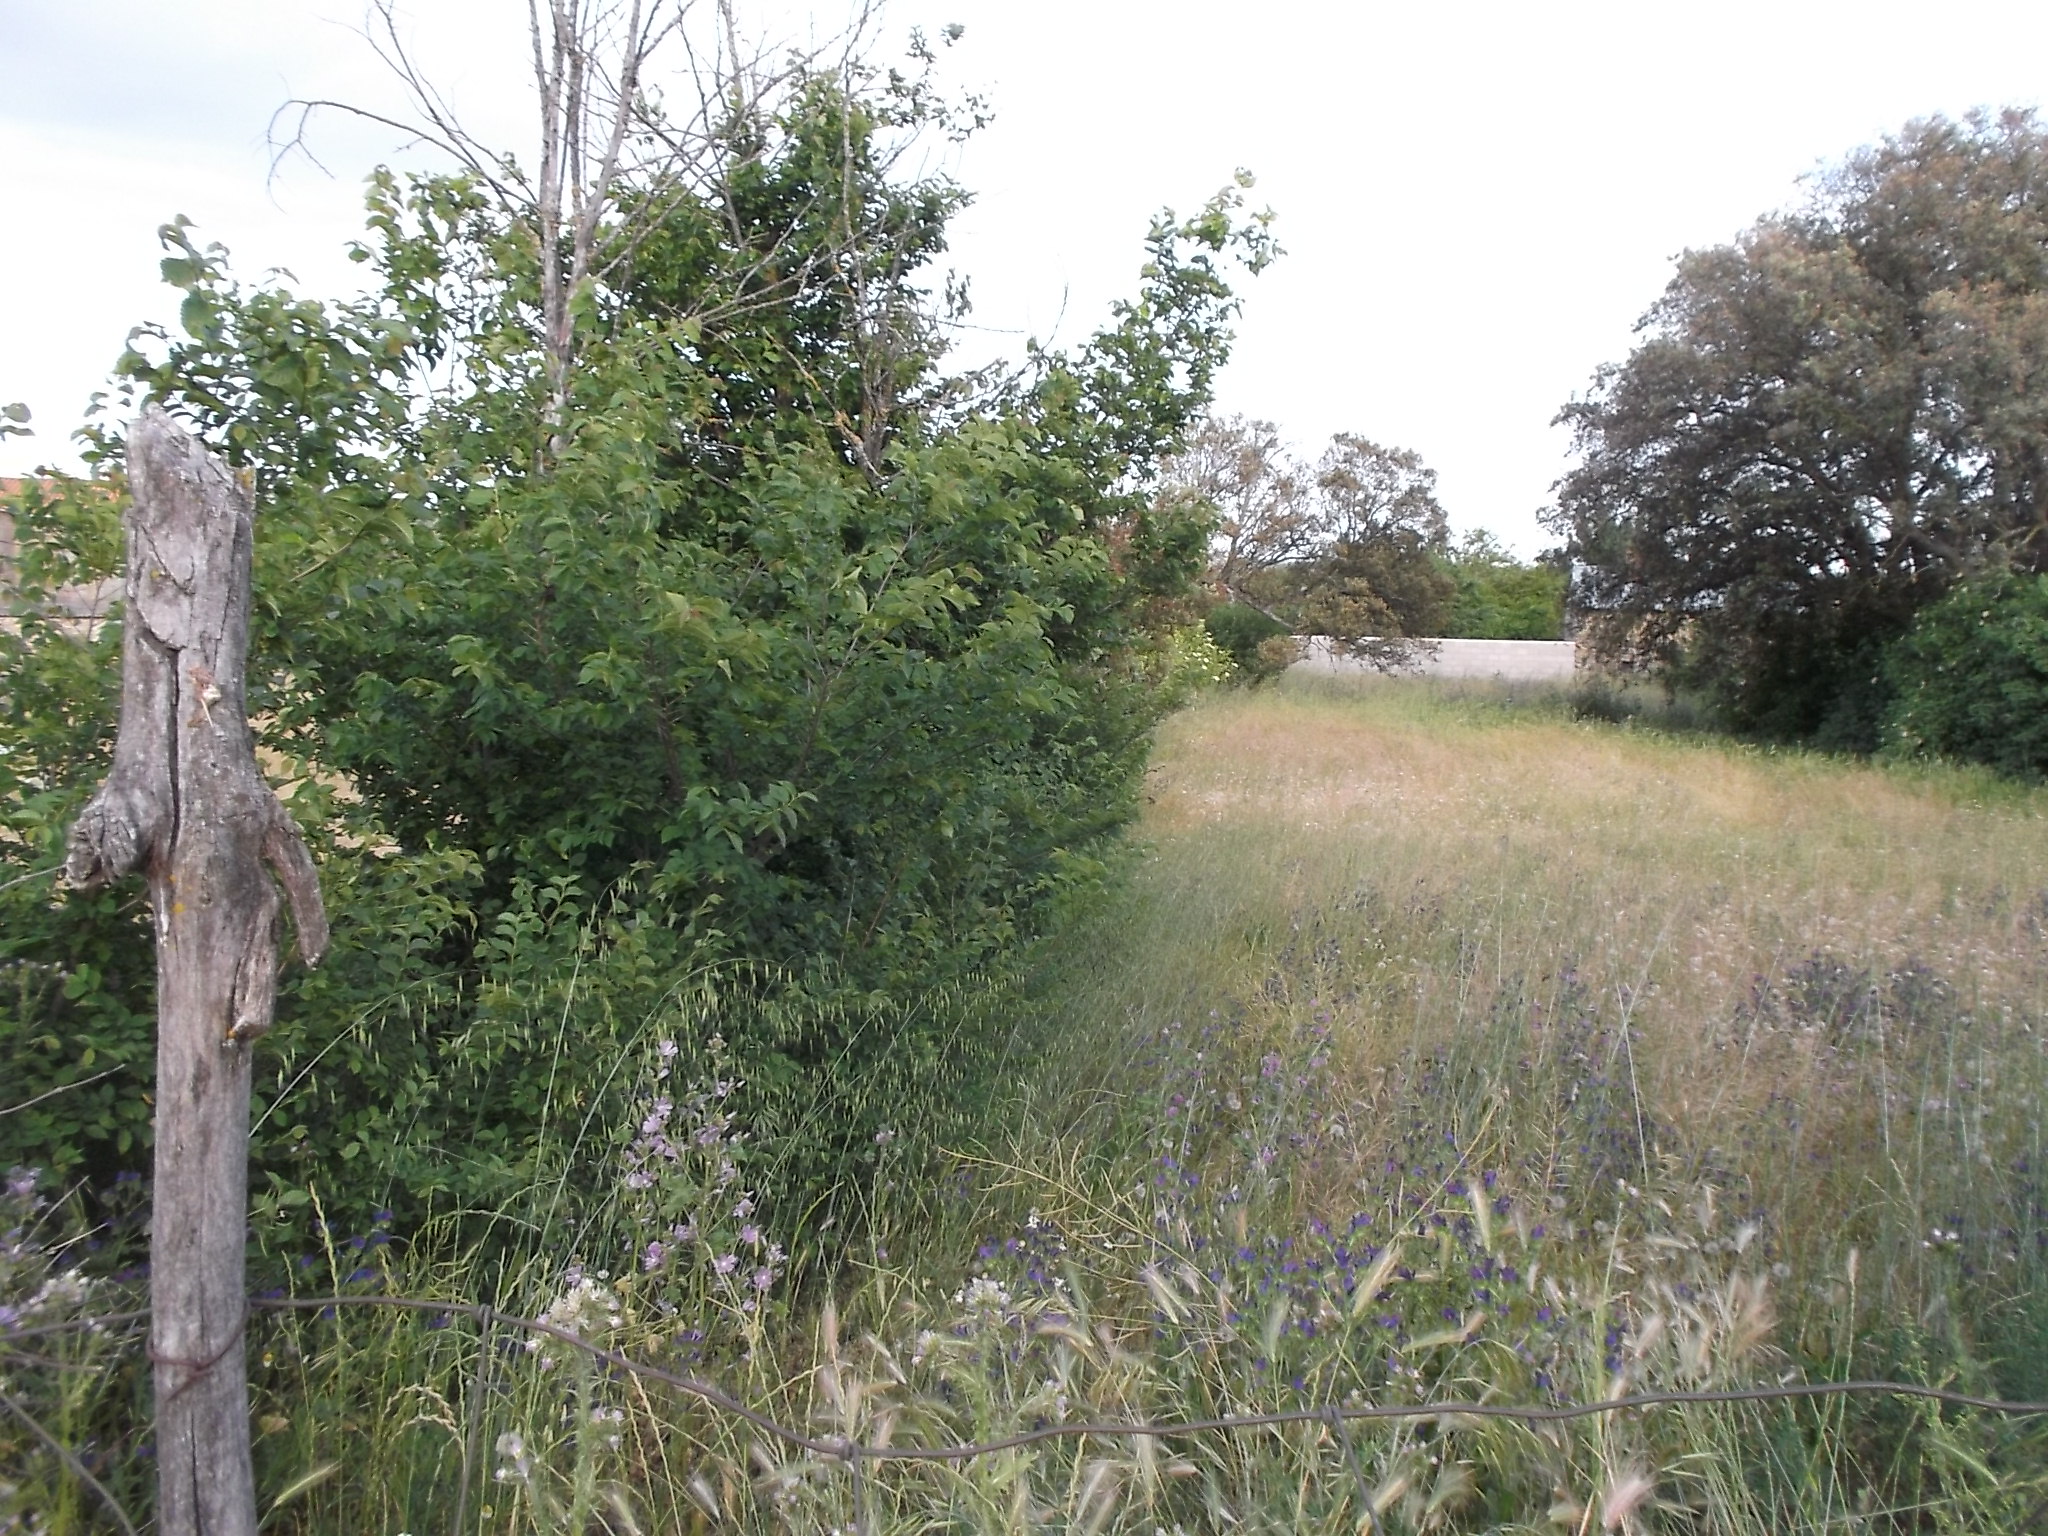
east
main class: Grassland
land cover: Grassland without tree/shrub cover
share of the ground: > 75 %
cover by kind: herbaceous plants 100 %
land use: Agriculture (excluding fallow land and kitchen gardens)
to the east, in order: Grassland without tree/shrub cover; Artificial constructions in urban areas; Grassland without tree/shrub cover; Fences; Grass margins; Mixed cereals for fodder; Artificial constructions in urban areas; Grassland without tree/shrub cover; Artificial constructions in urban areas; Grassland without tree/shrub cover; Dry stone walls; Fences; Grassland without tree/shrub cover
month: May
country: ES
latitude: 41.1127
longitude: -6.3491
